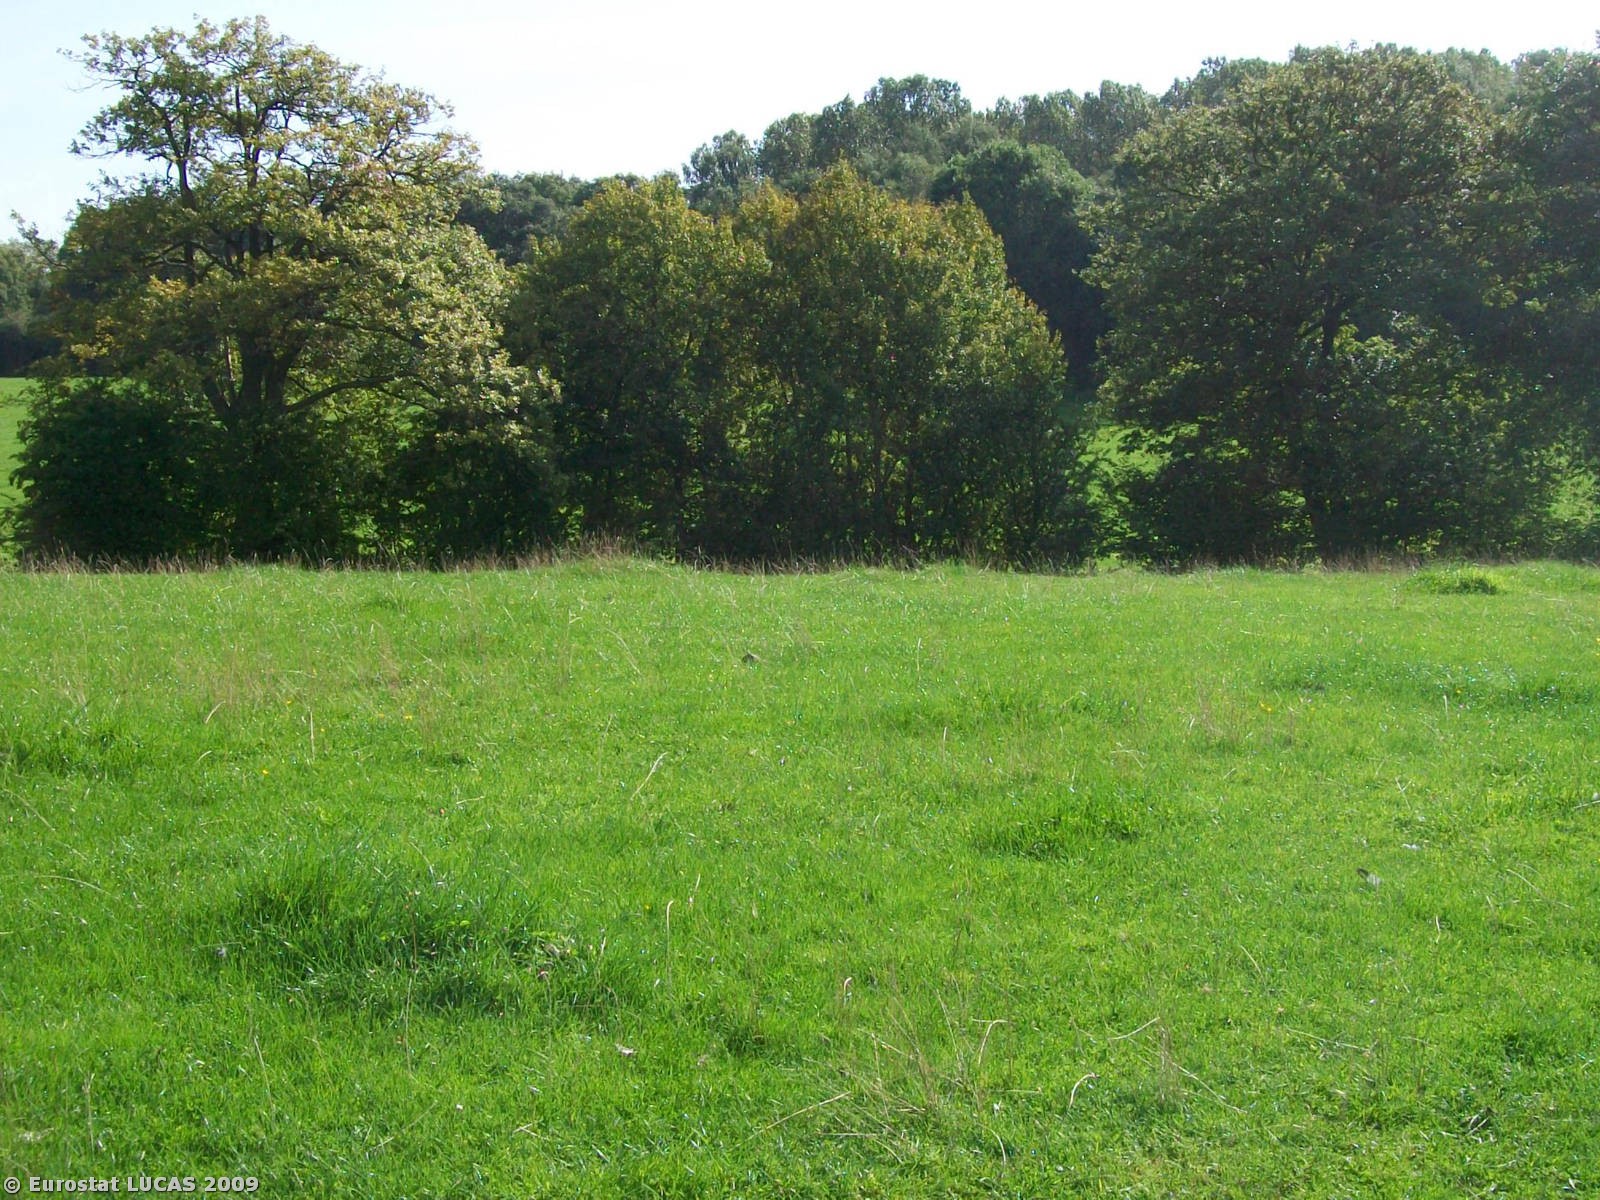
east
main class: Grassland
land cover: Grassland without tree/shrub cover
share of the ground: > 75 %
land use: Agriculture (excluding fallow land and kitchen gardens)
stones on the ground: < 10 %
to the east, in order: Grassland without tree/shrub cover; Broadleaved woodland; Fences; Rivers and streams; Grassland without tree/shrub cover
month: September
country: GB
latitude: 52.2652
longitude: -2.4470
